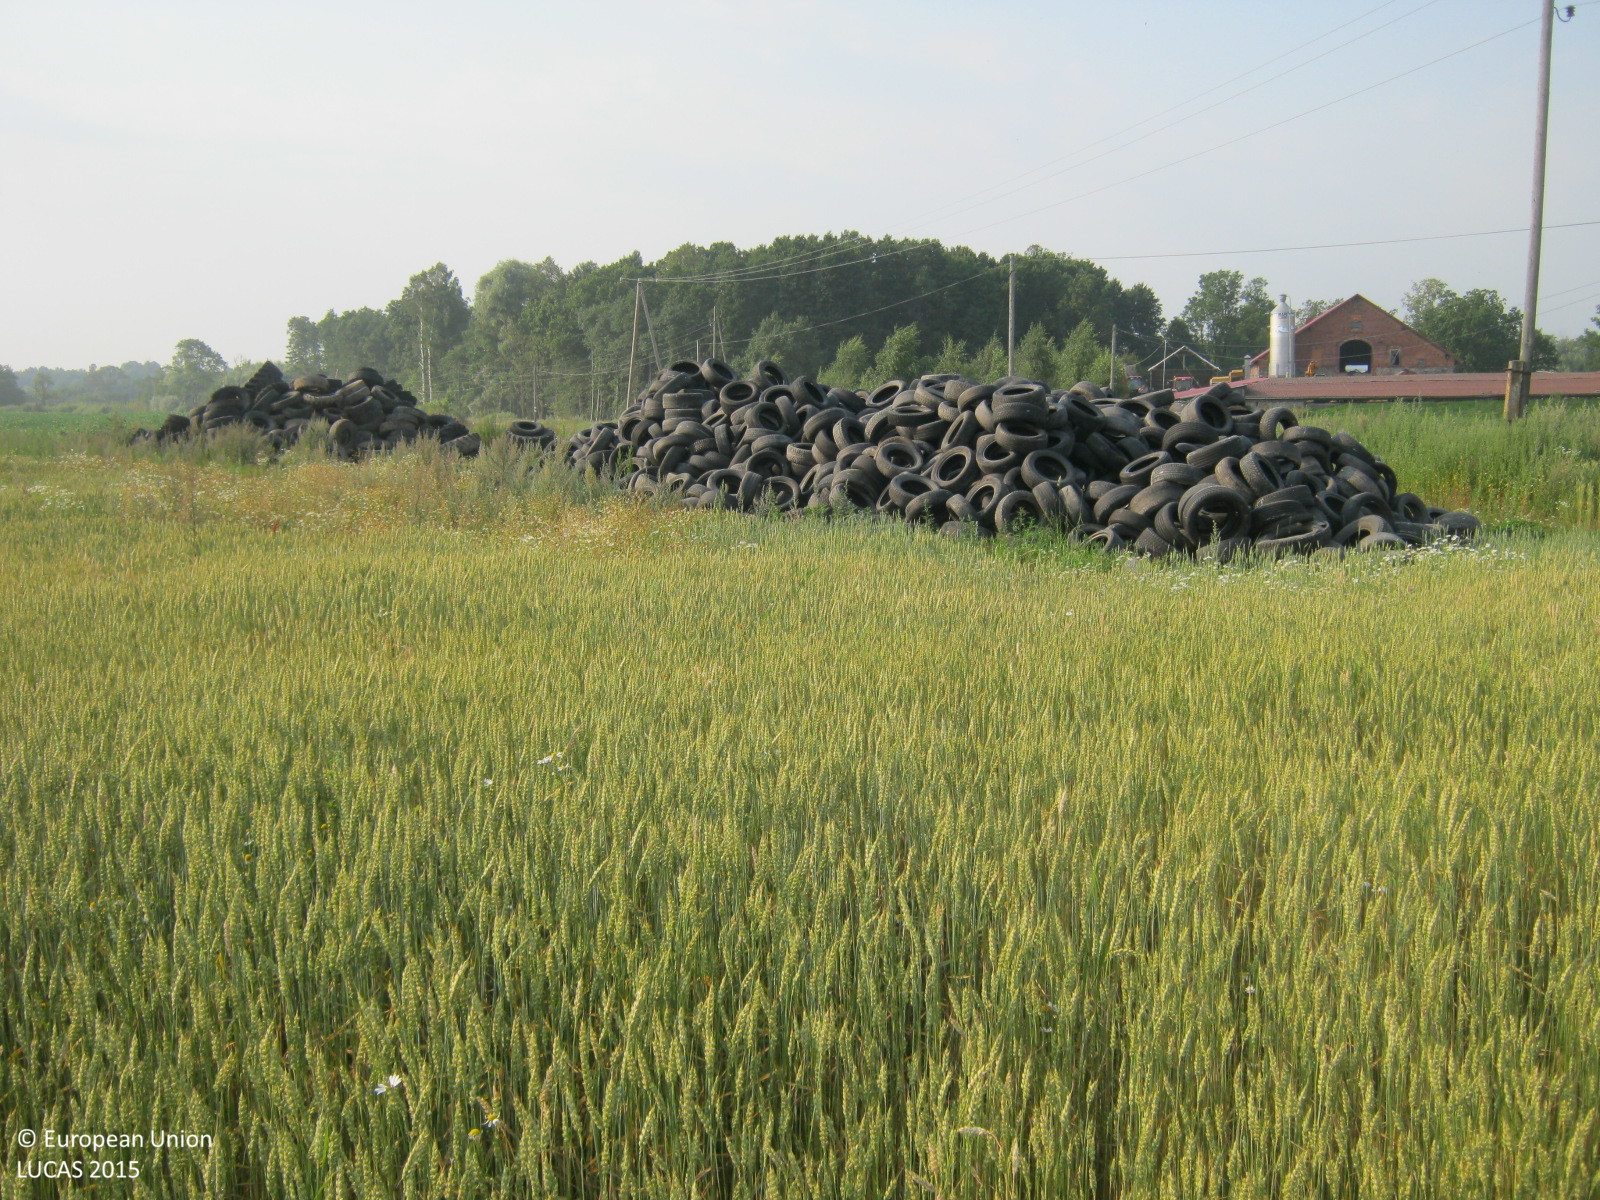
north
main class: Cropland
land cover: Common wheat
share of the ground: > 75 %
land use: Agriculture (excluding fallow land and kitchen gardens)
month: August
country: LV
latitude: 57.4267
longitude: 24.6673
